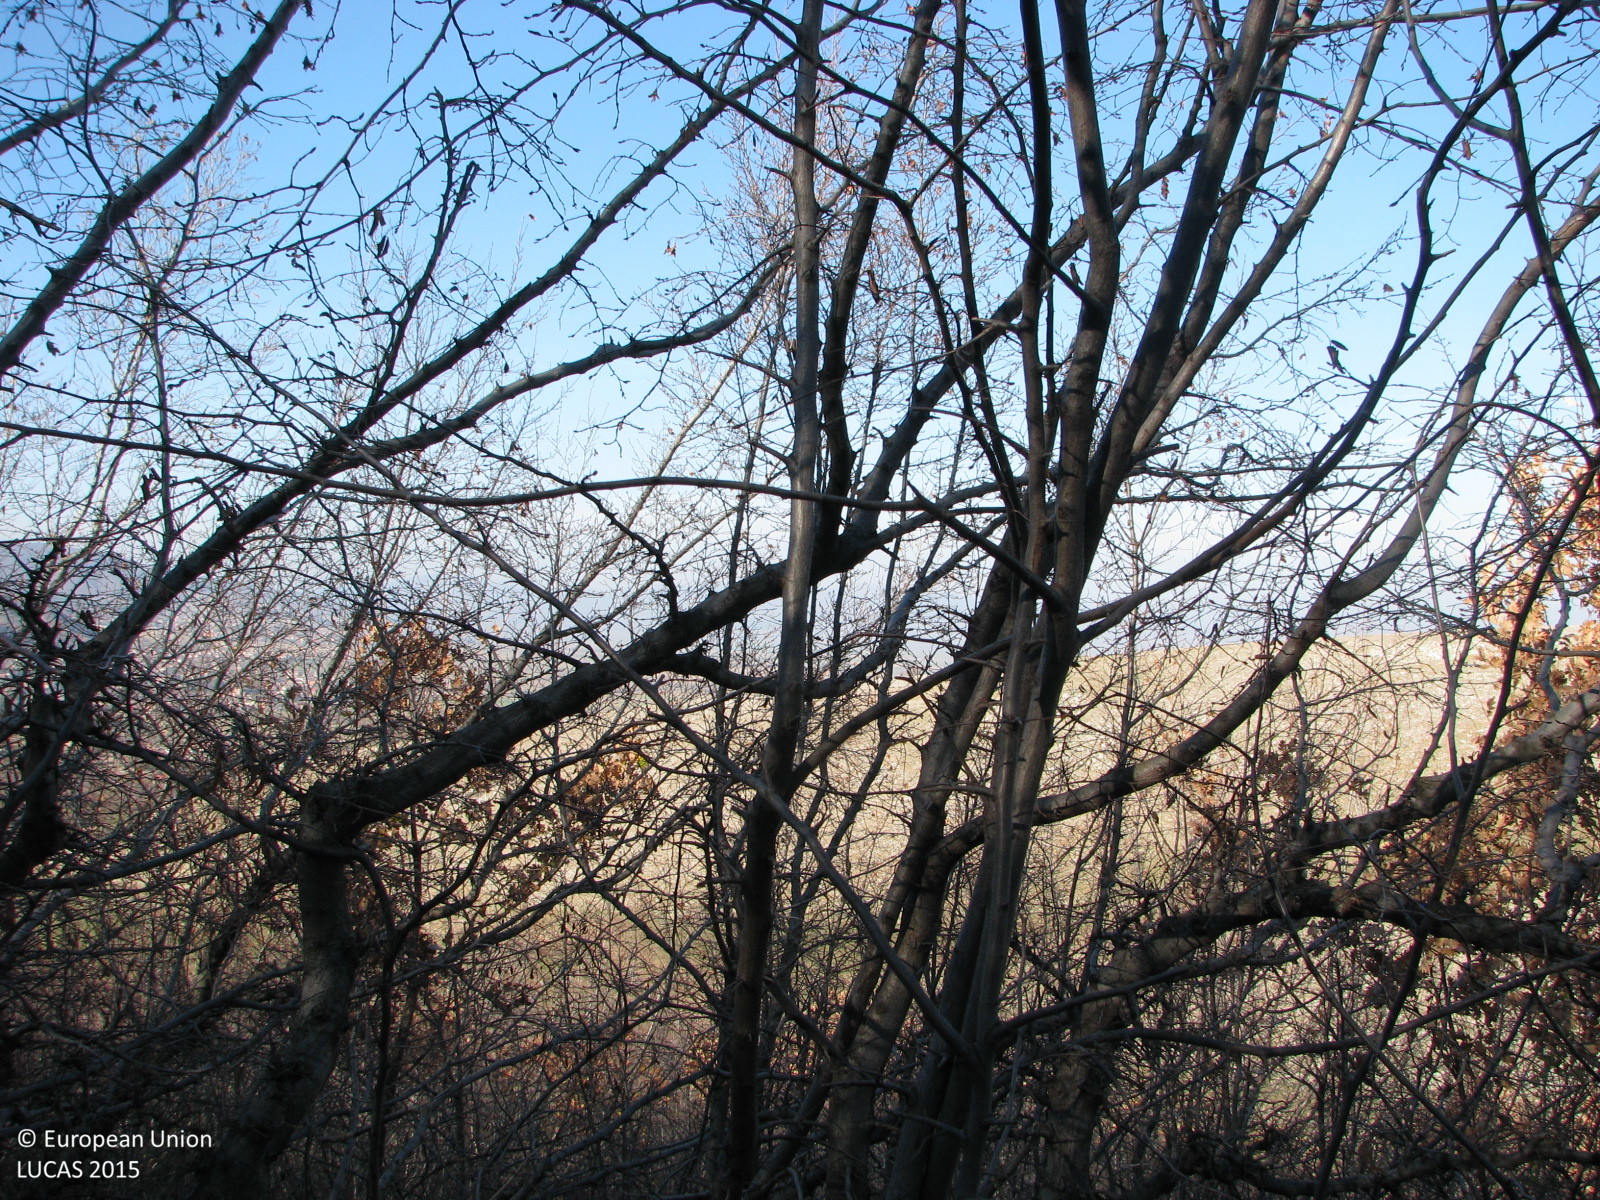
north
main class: Woodland
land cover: Broadleaved woodland
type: mesophytic deciduous forest
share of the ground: > 75 %
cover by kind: broadleaved forest trees 90 %, shrubs 5 %, unconsolidated bare surface 5 %
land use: Semi-natural and natural areas not in use
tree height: < 5 m
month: December
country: BG
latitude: 42.1474
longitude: 24.1630
